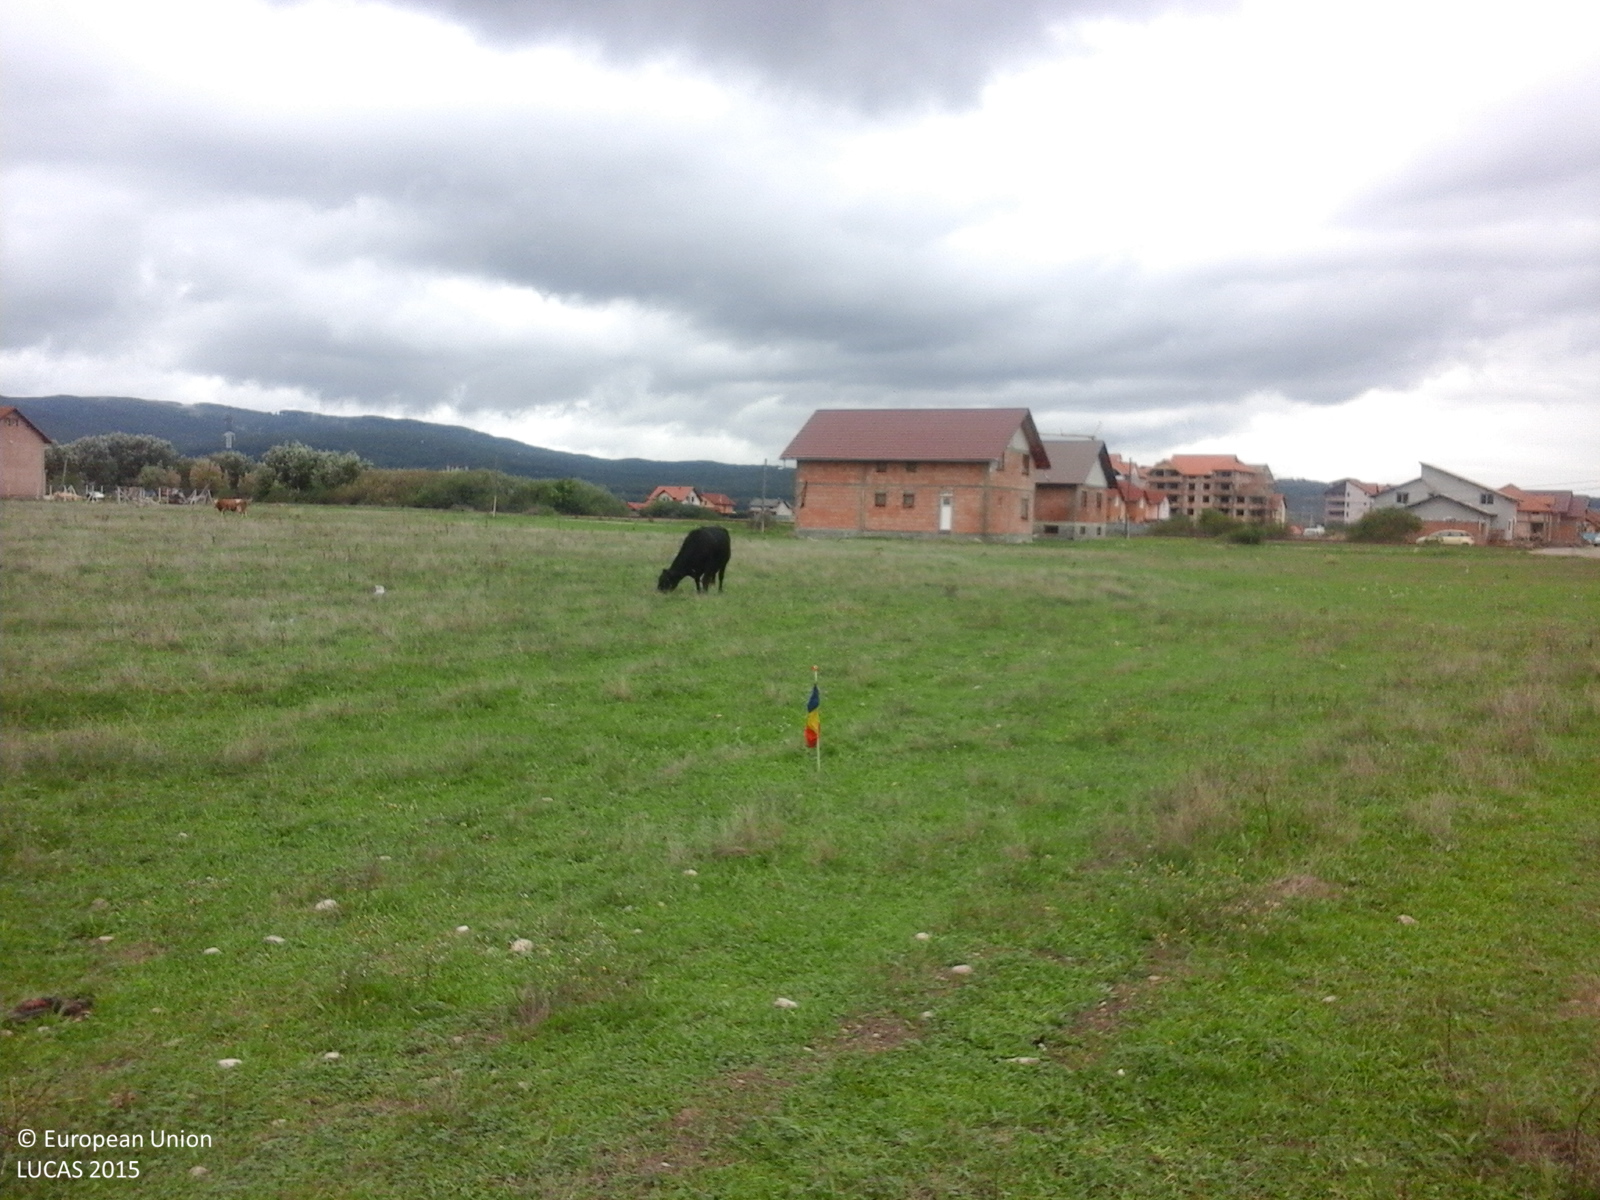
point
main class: Grassland
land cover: Grassland without tree/shrub cover
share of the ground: > 75 %
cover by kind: herbaceous plants 100 %
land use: Agriculture (excluding fallow land and kitchen gardens)
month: September
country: RO
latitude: 45.9380
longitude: 23.5695
